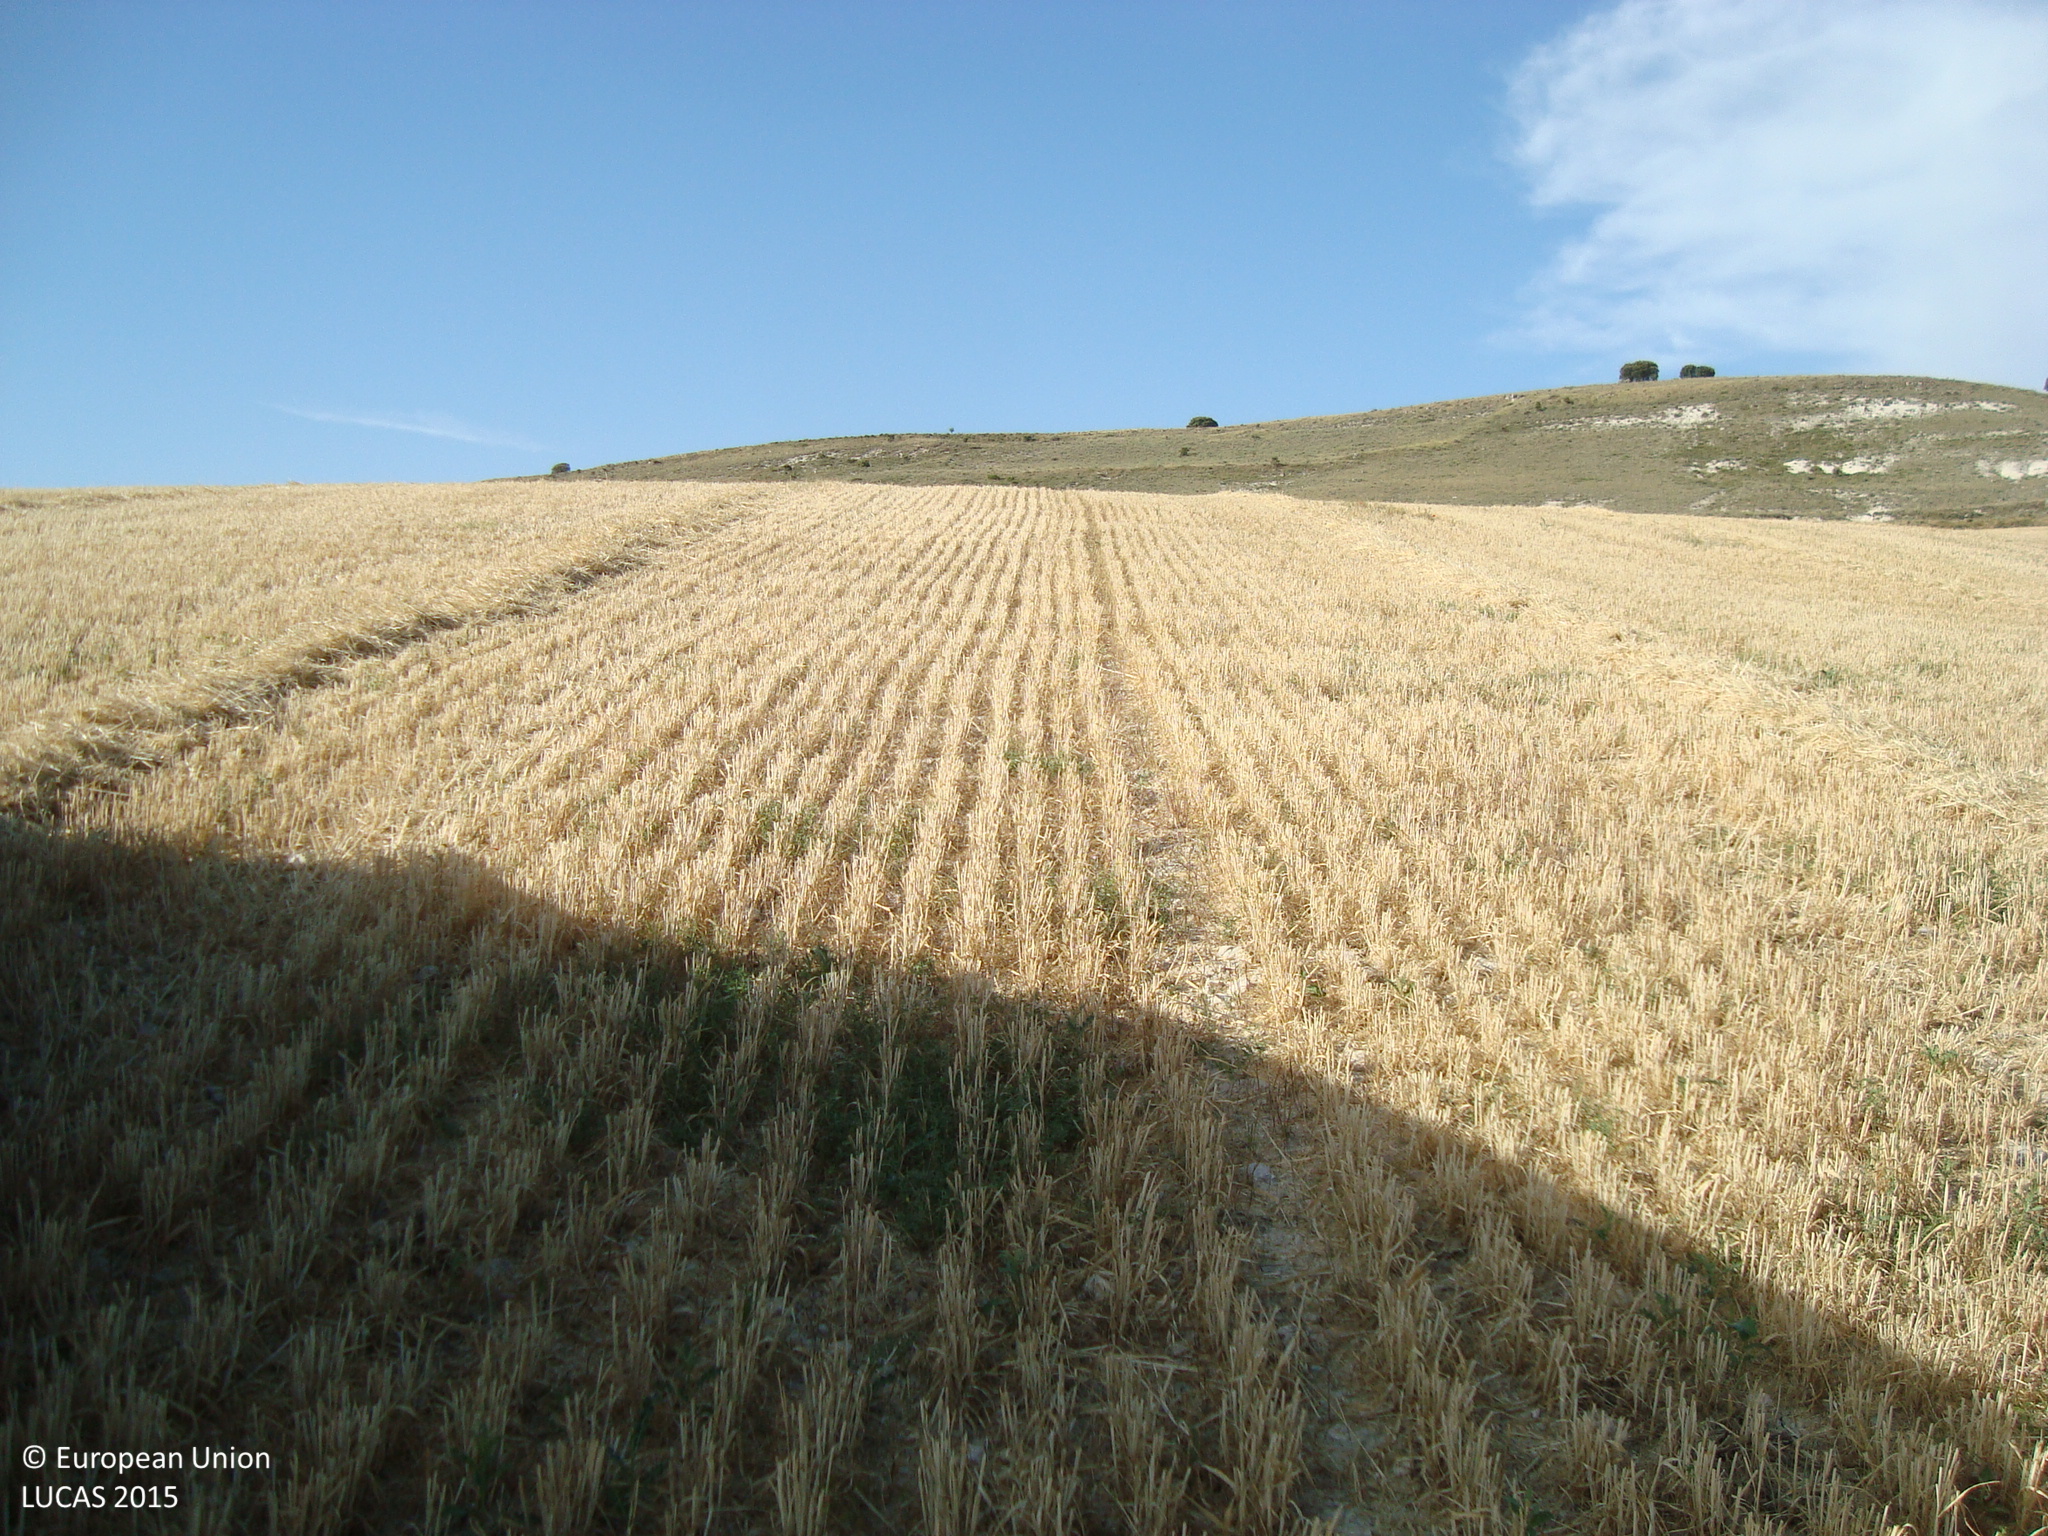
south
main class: Cropland
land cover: Barley
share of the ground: > 75 %
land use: Agriculture (excluding fallow land and kitchen gardens)
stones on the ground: 10 - 25 %
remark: Harvested field
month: July
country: ES
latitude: 41.8648
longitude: -4.2188
